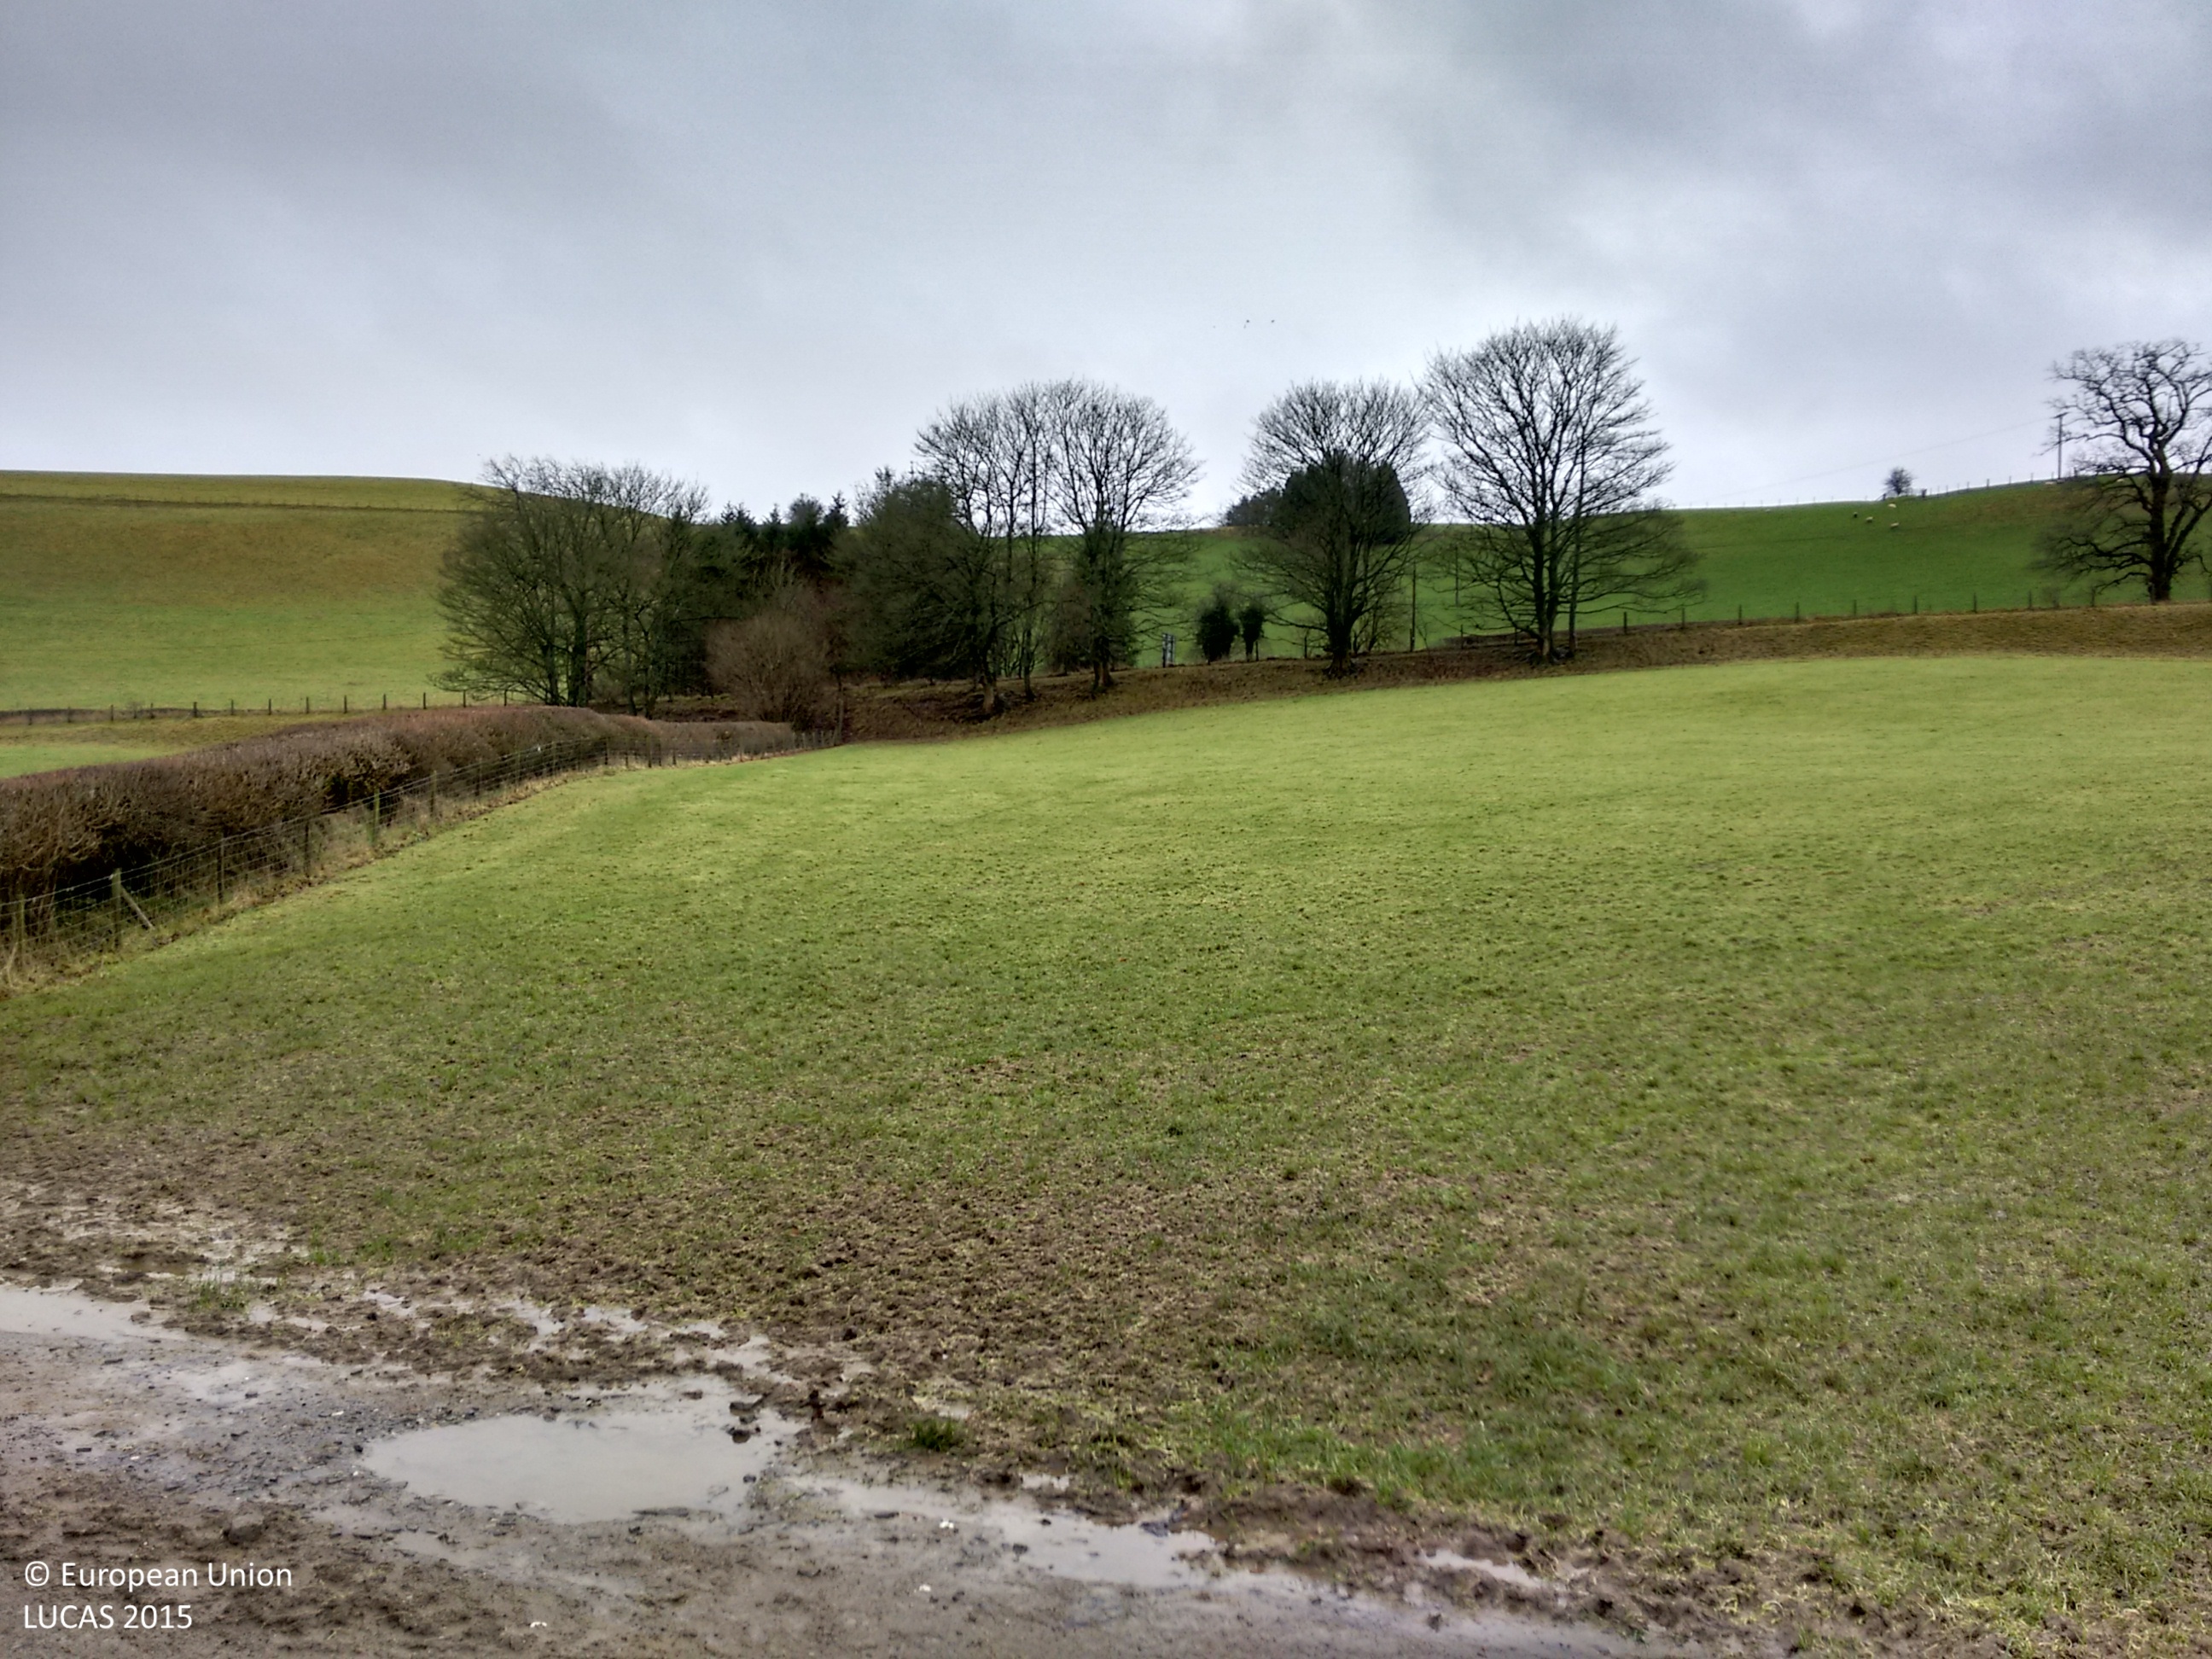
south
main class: Grassland
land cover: Grassland without tree/shrub cover
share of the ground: > 75 %
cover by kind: herbaceous plants 100 %
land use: Agriculture (excluding fallow land and kitchen gardens)
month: December
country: GB
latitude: 52.2185
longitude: -3.2086
